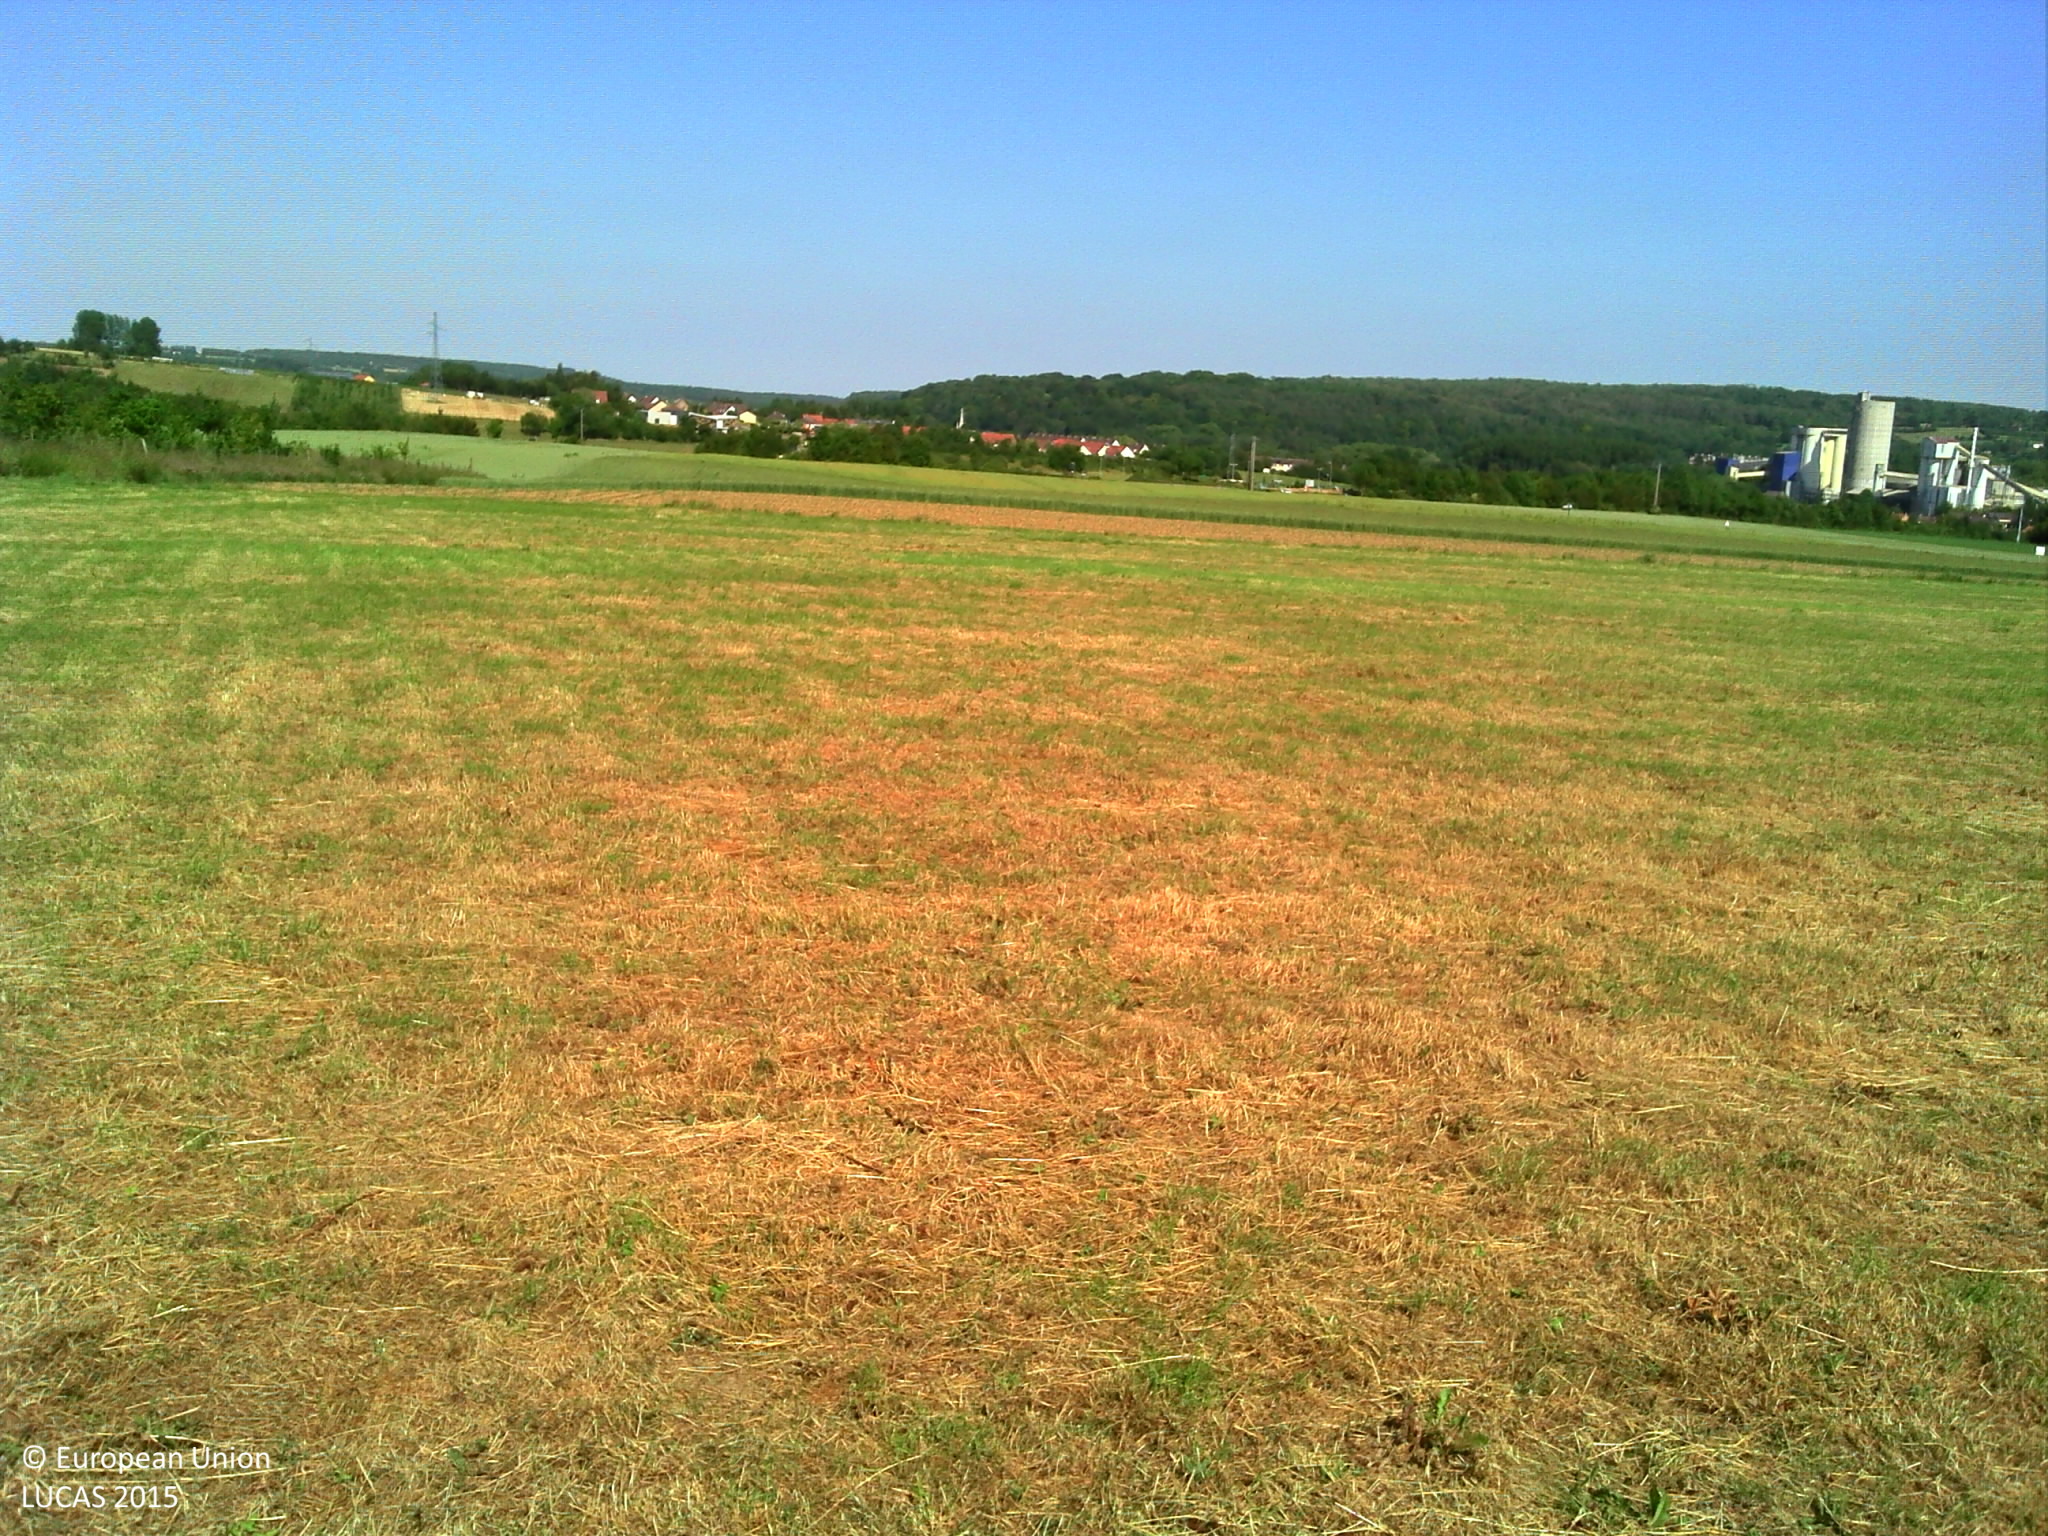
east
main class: Grassland
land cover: Grassland without tree/shrub cover
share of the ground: > 75 %
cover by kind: herbaceous plants 100 %
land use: Agriculture (excluding fallow land and kitchen gardens)
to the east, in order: Grassland without tree/shrub cover; Maize; Common wheat; Rape and turnip rape
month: June
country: FR
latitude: 50.7047
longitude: 2.0978
